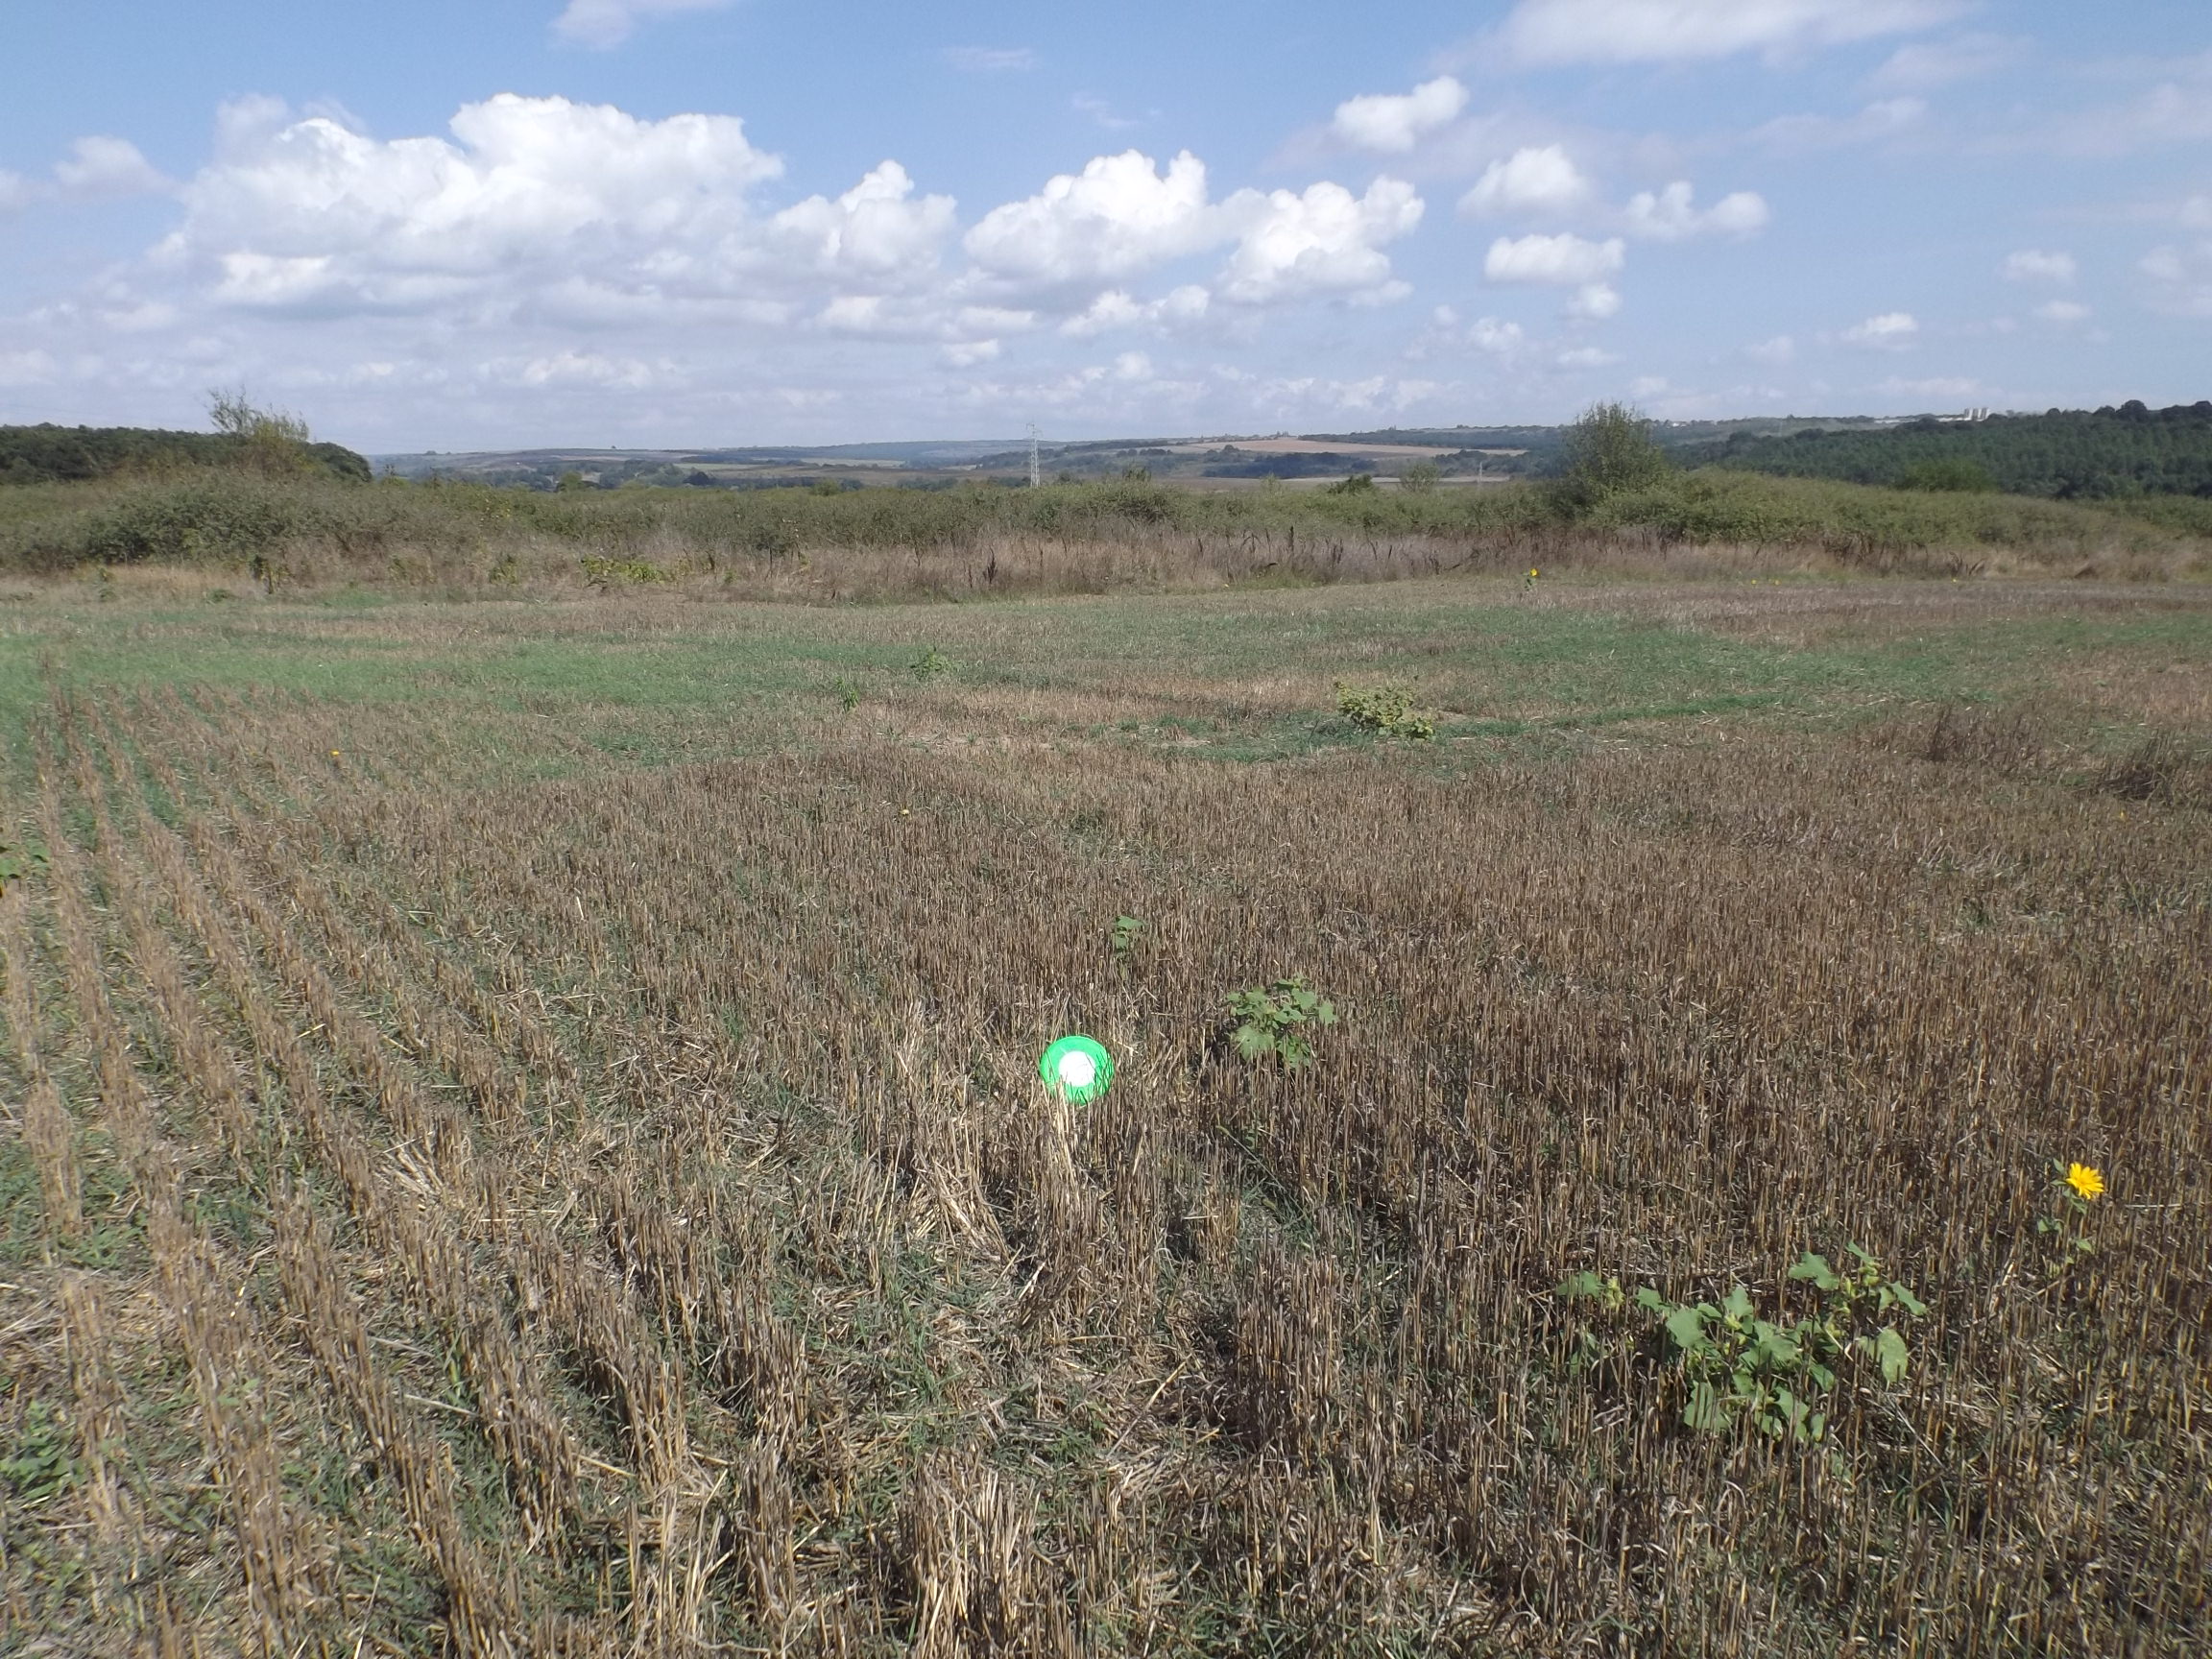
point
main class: Cropland
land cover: Common wheat
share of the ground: 25 - 50 %
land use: Agriculture (excluding fallow land and kitchen gardens)
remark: Harvested field
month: September
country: BG
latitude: 43.0282
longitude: 27.8437
